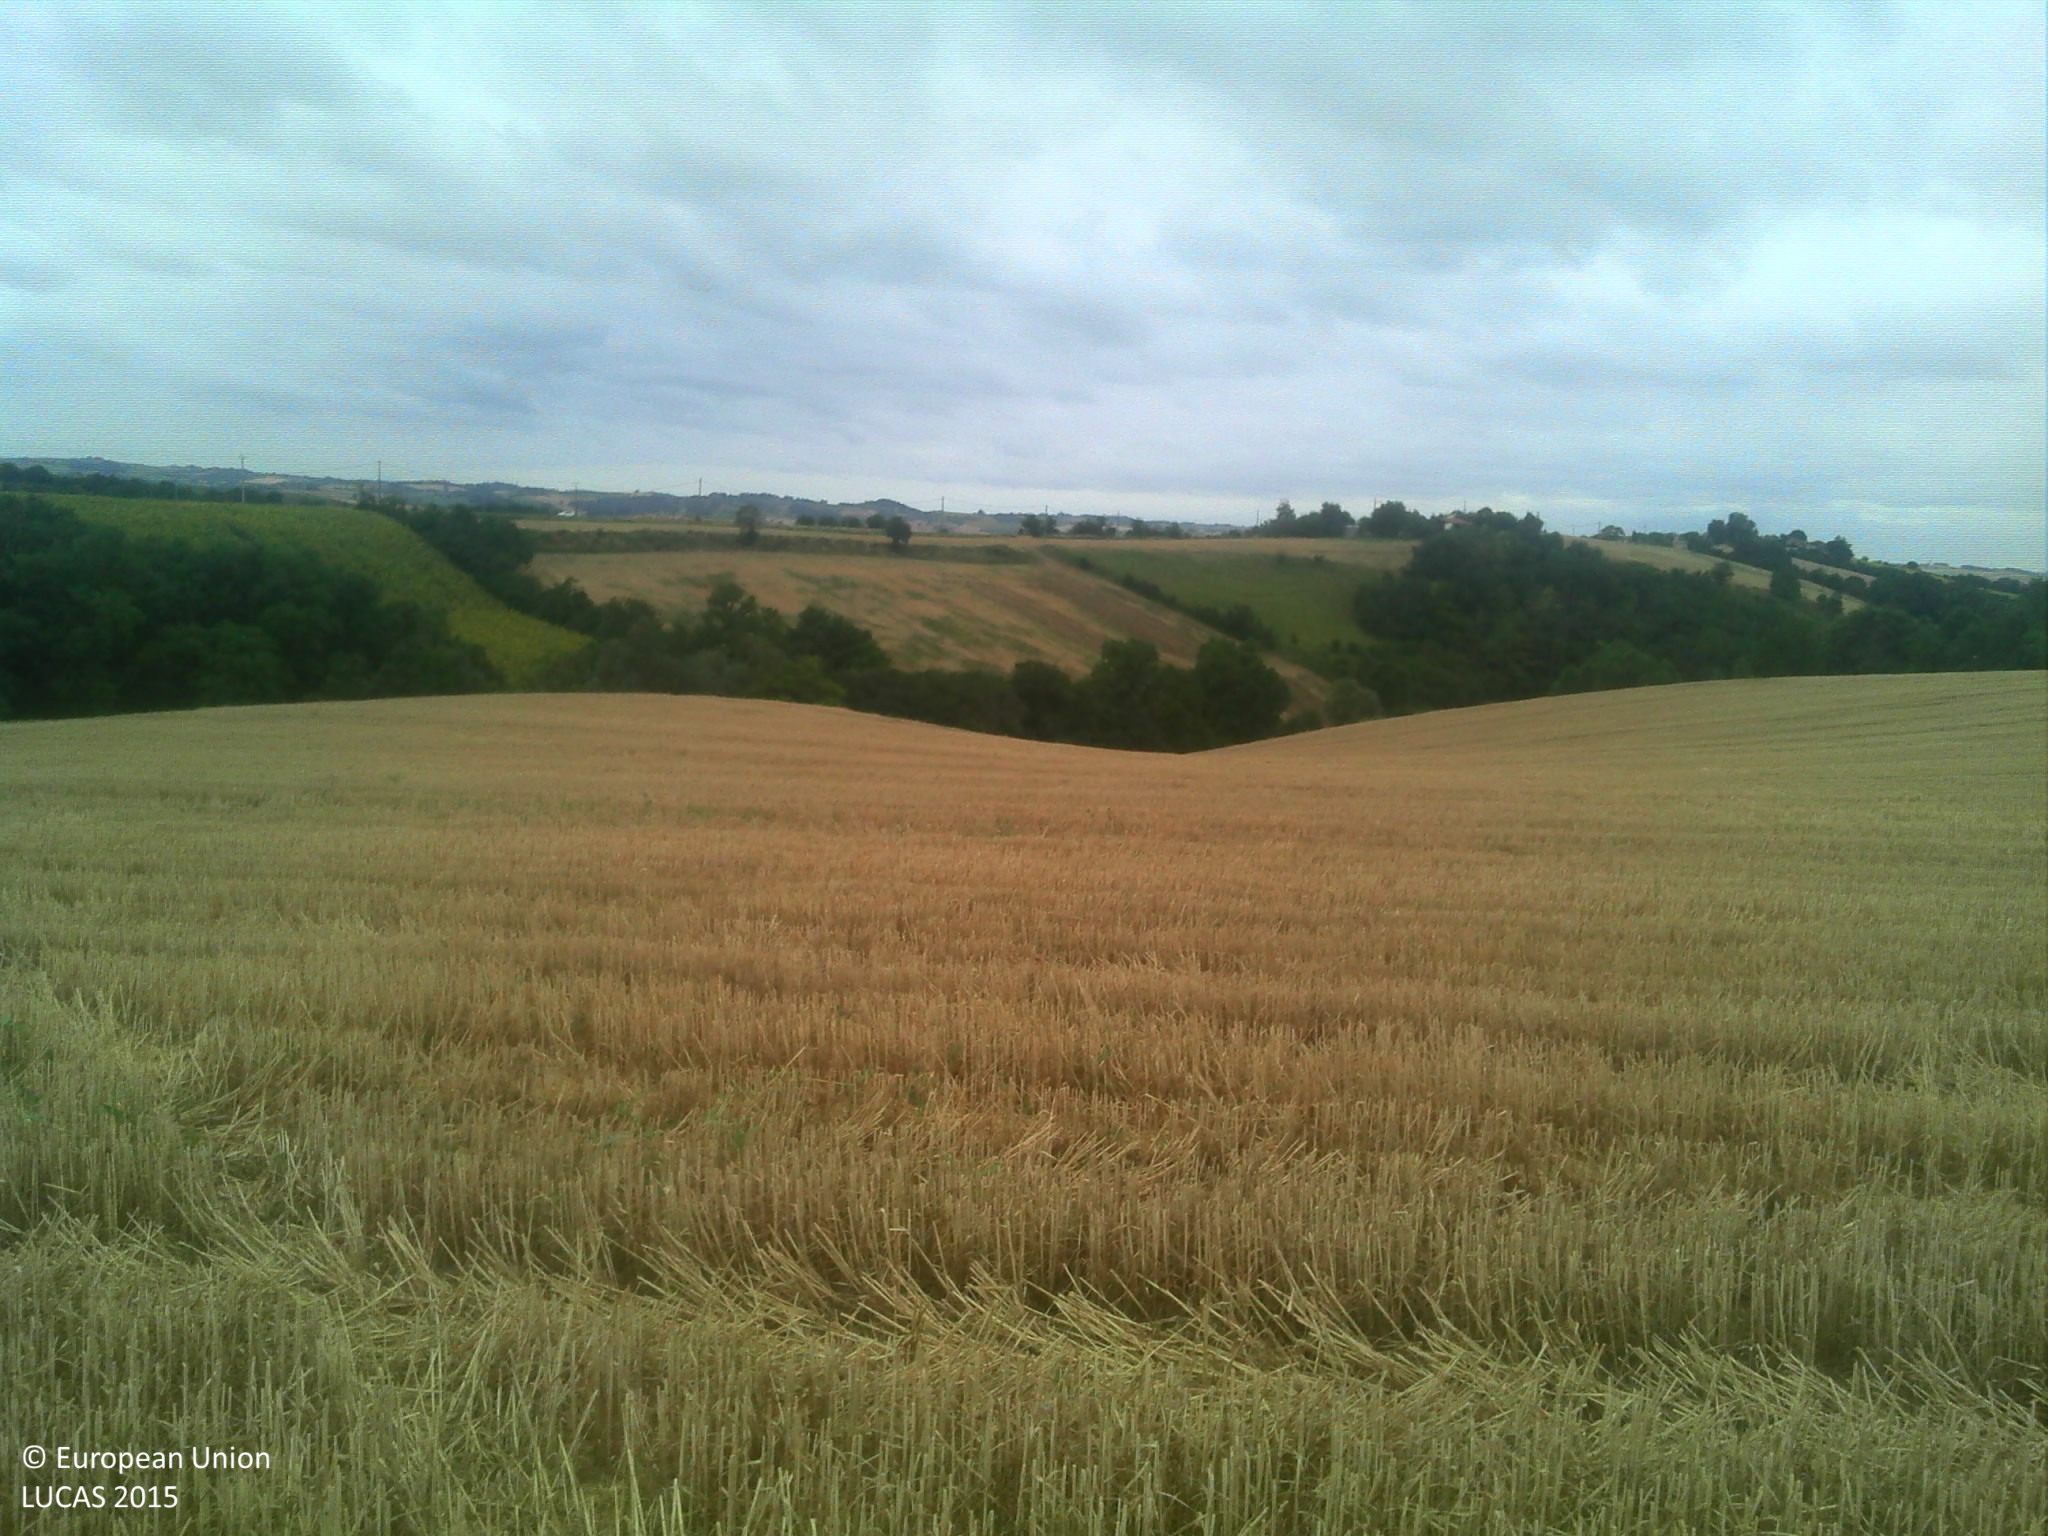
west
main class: Cropland
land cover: Common wheat
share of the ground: > 75 %
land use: Agriculture (excluding fallow land and kitchen gardens)
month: July
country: FR
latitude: 43.2332
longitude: 1.4221
